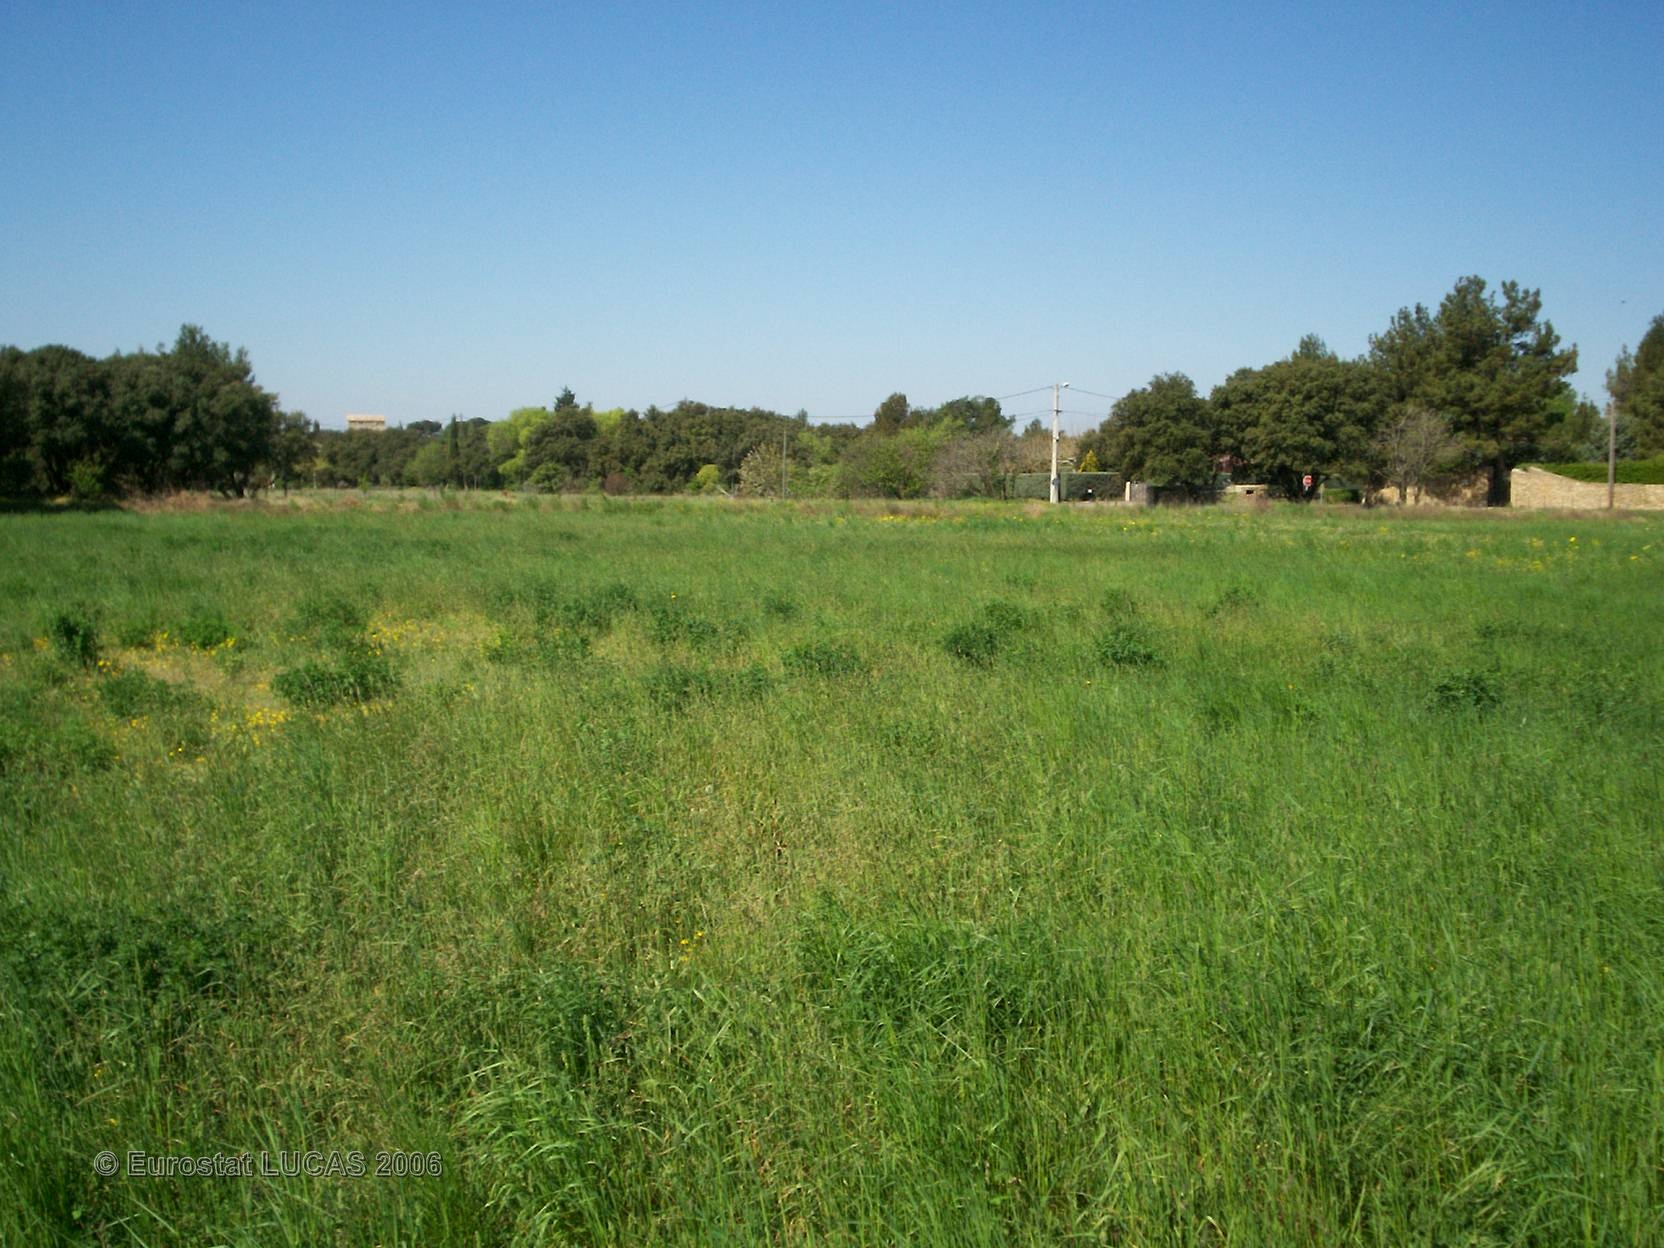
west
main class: Grassland
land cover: Grassland without tree/shrub cover
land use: Agriculture (excluding fallow land and kitchen gardens)
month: April
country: FR
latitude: 43.5839
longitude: 5.0930
